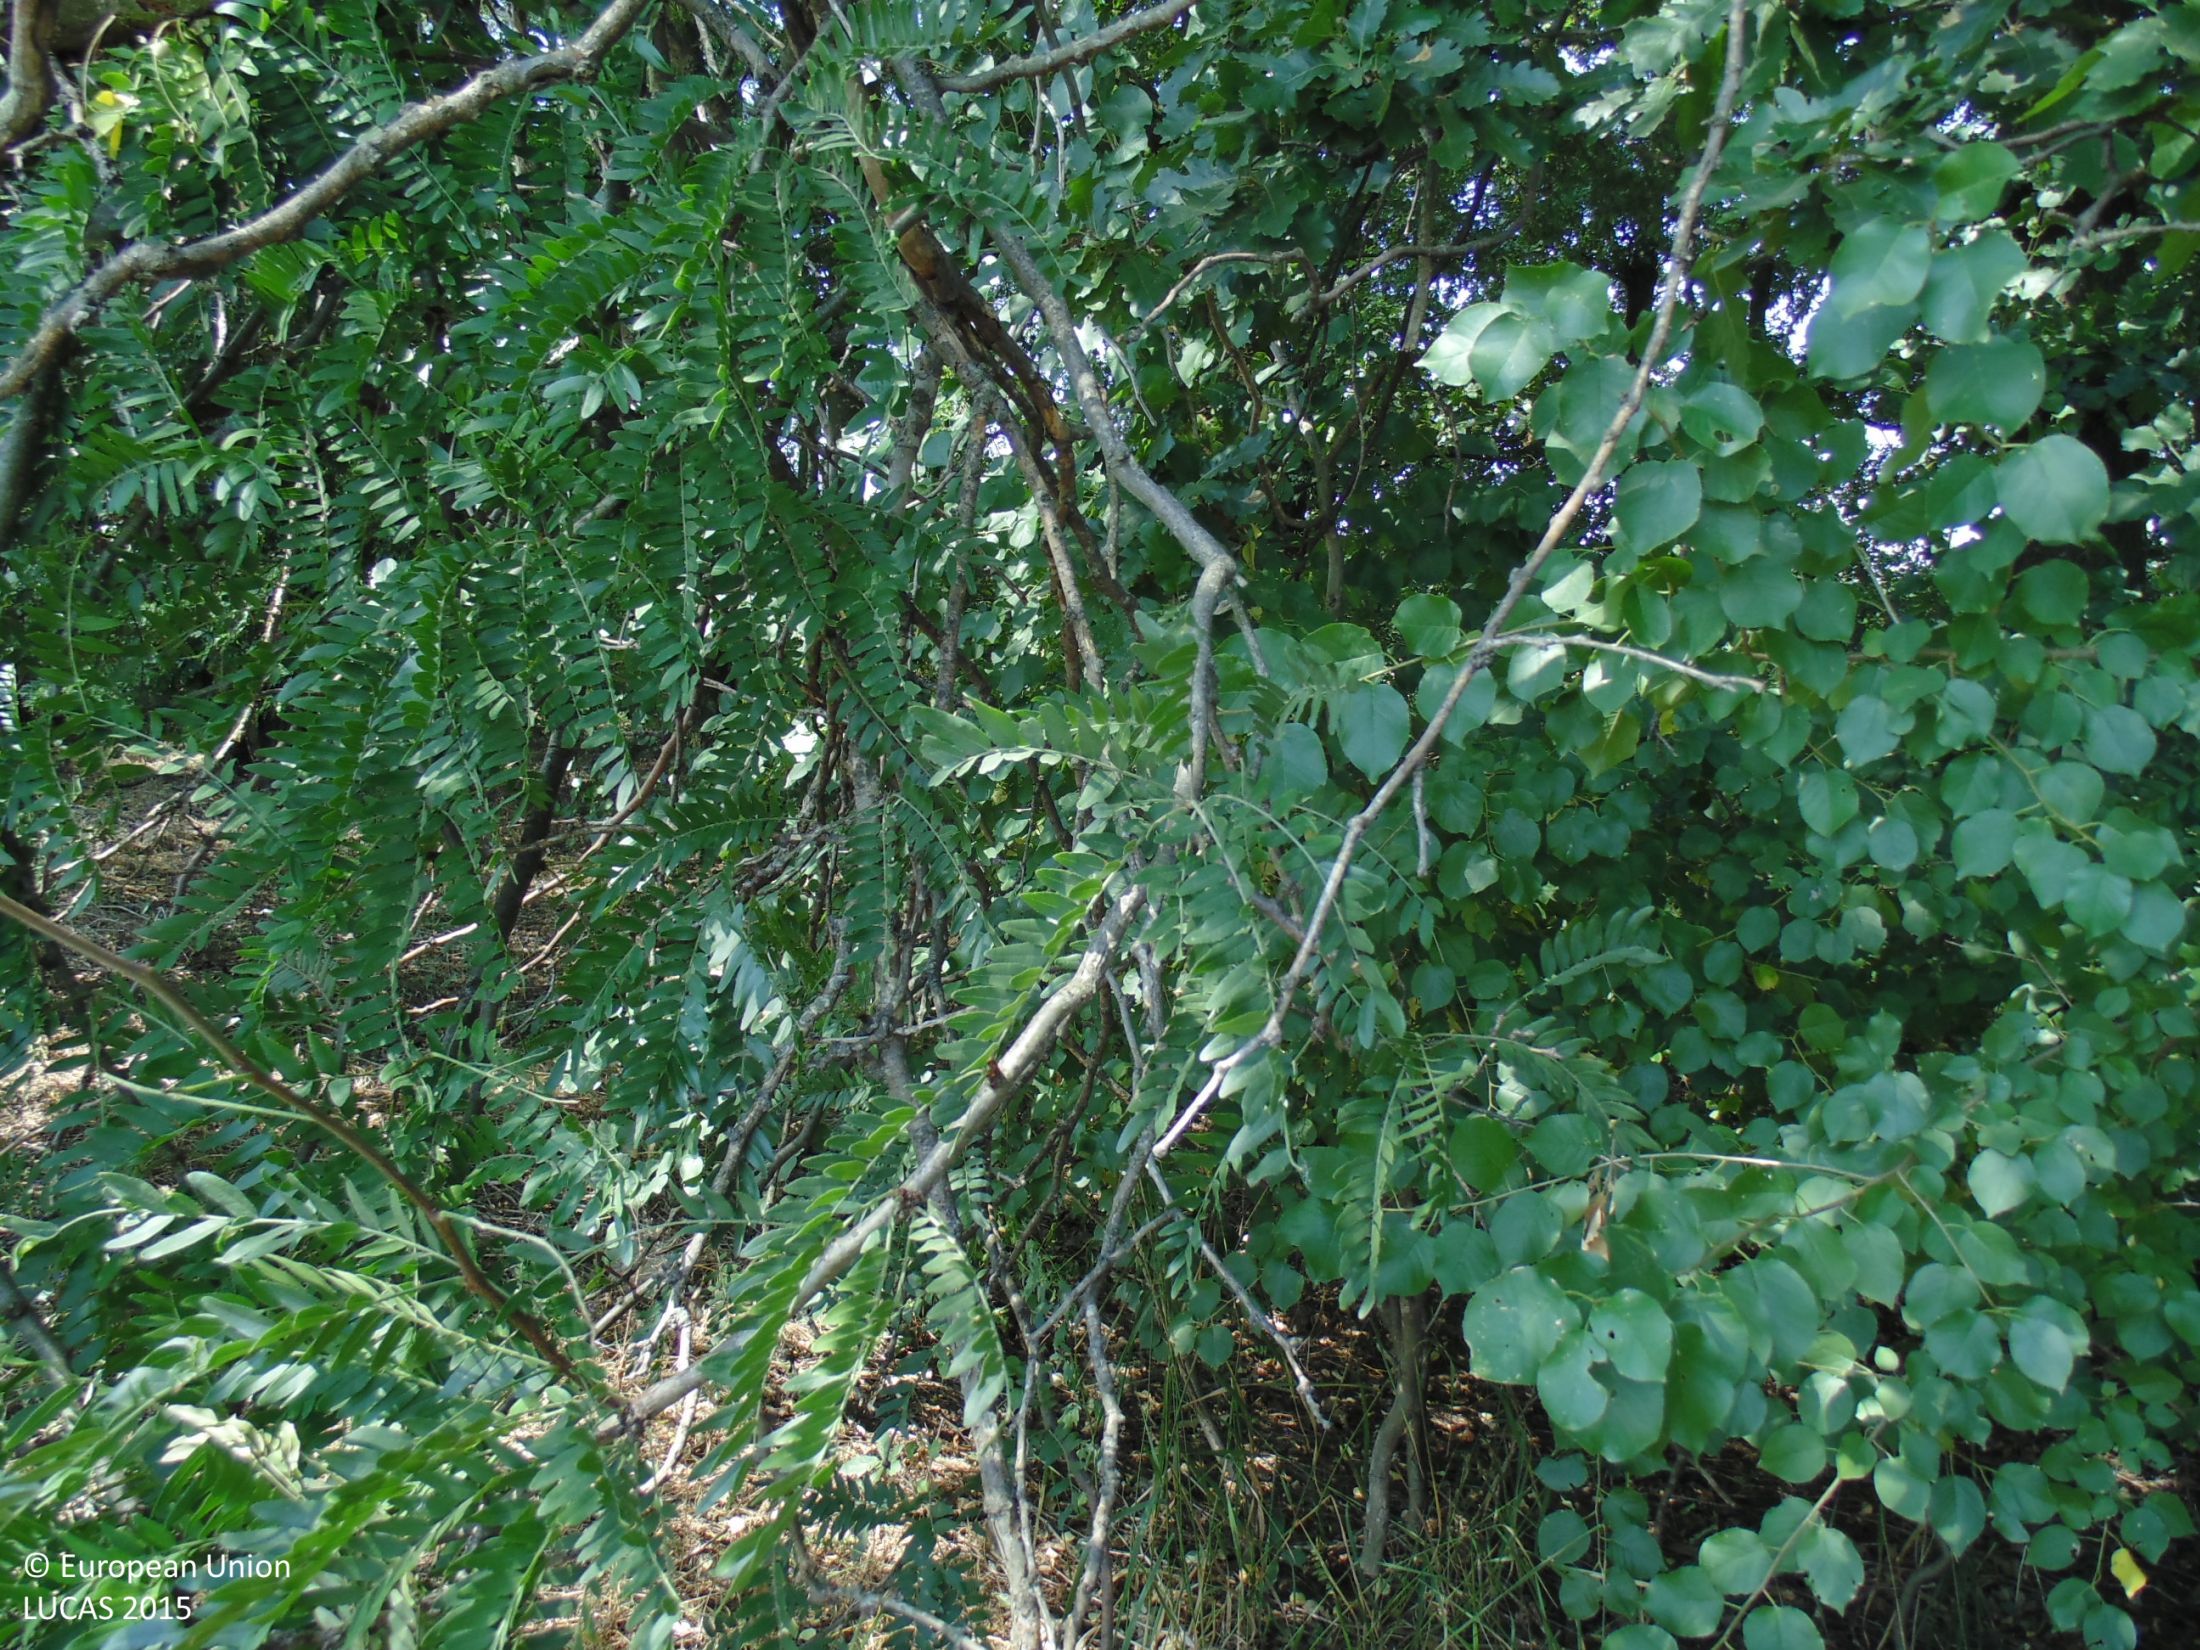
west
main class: Woodland
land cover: Broadleaved woodland
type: mesophytic deciduous forest
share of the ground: > 75 %
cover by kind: broadleaved forest trees 90 %, shrubs 5 %, unconsolidated bare surface 5 %
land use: Forestry
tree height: > 5 m
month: August
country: BG
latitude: 43.7469
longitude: 27.6352
